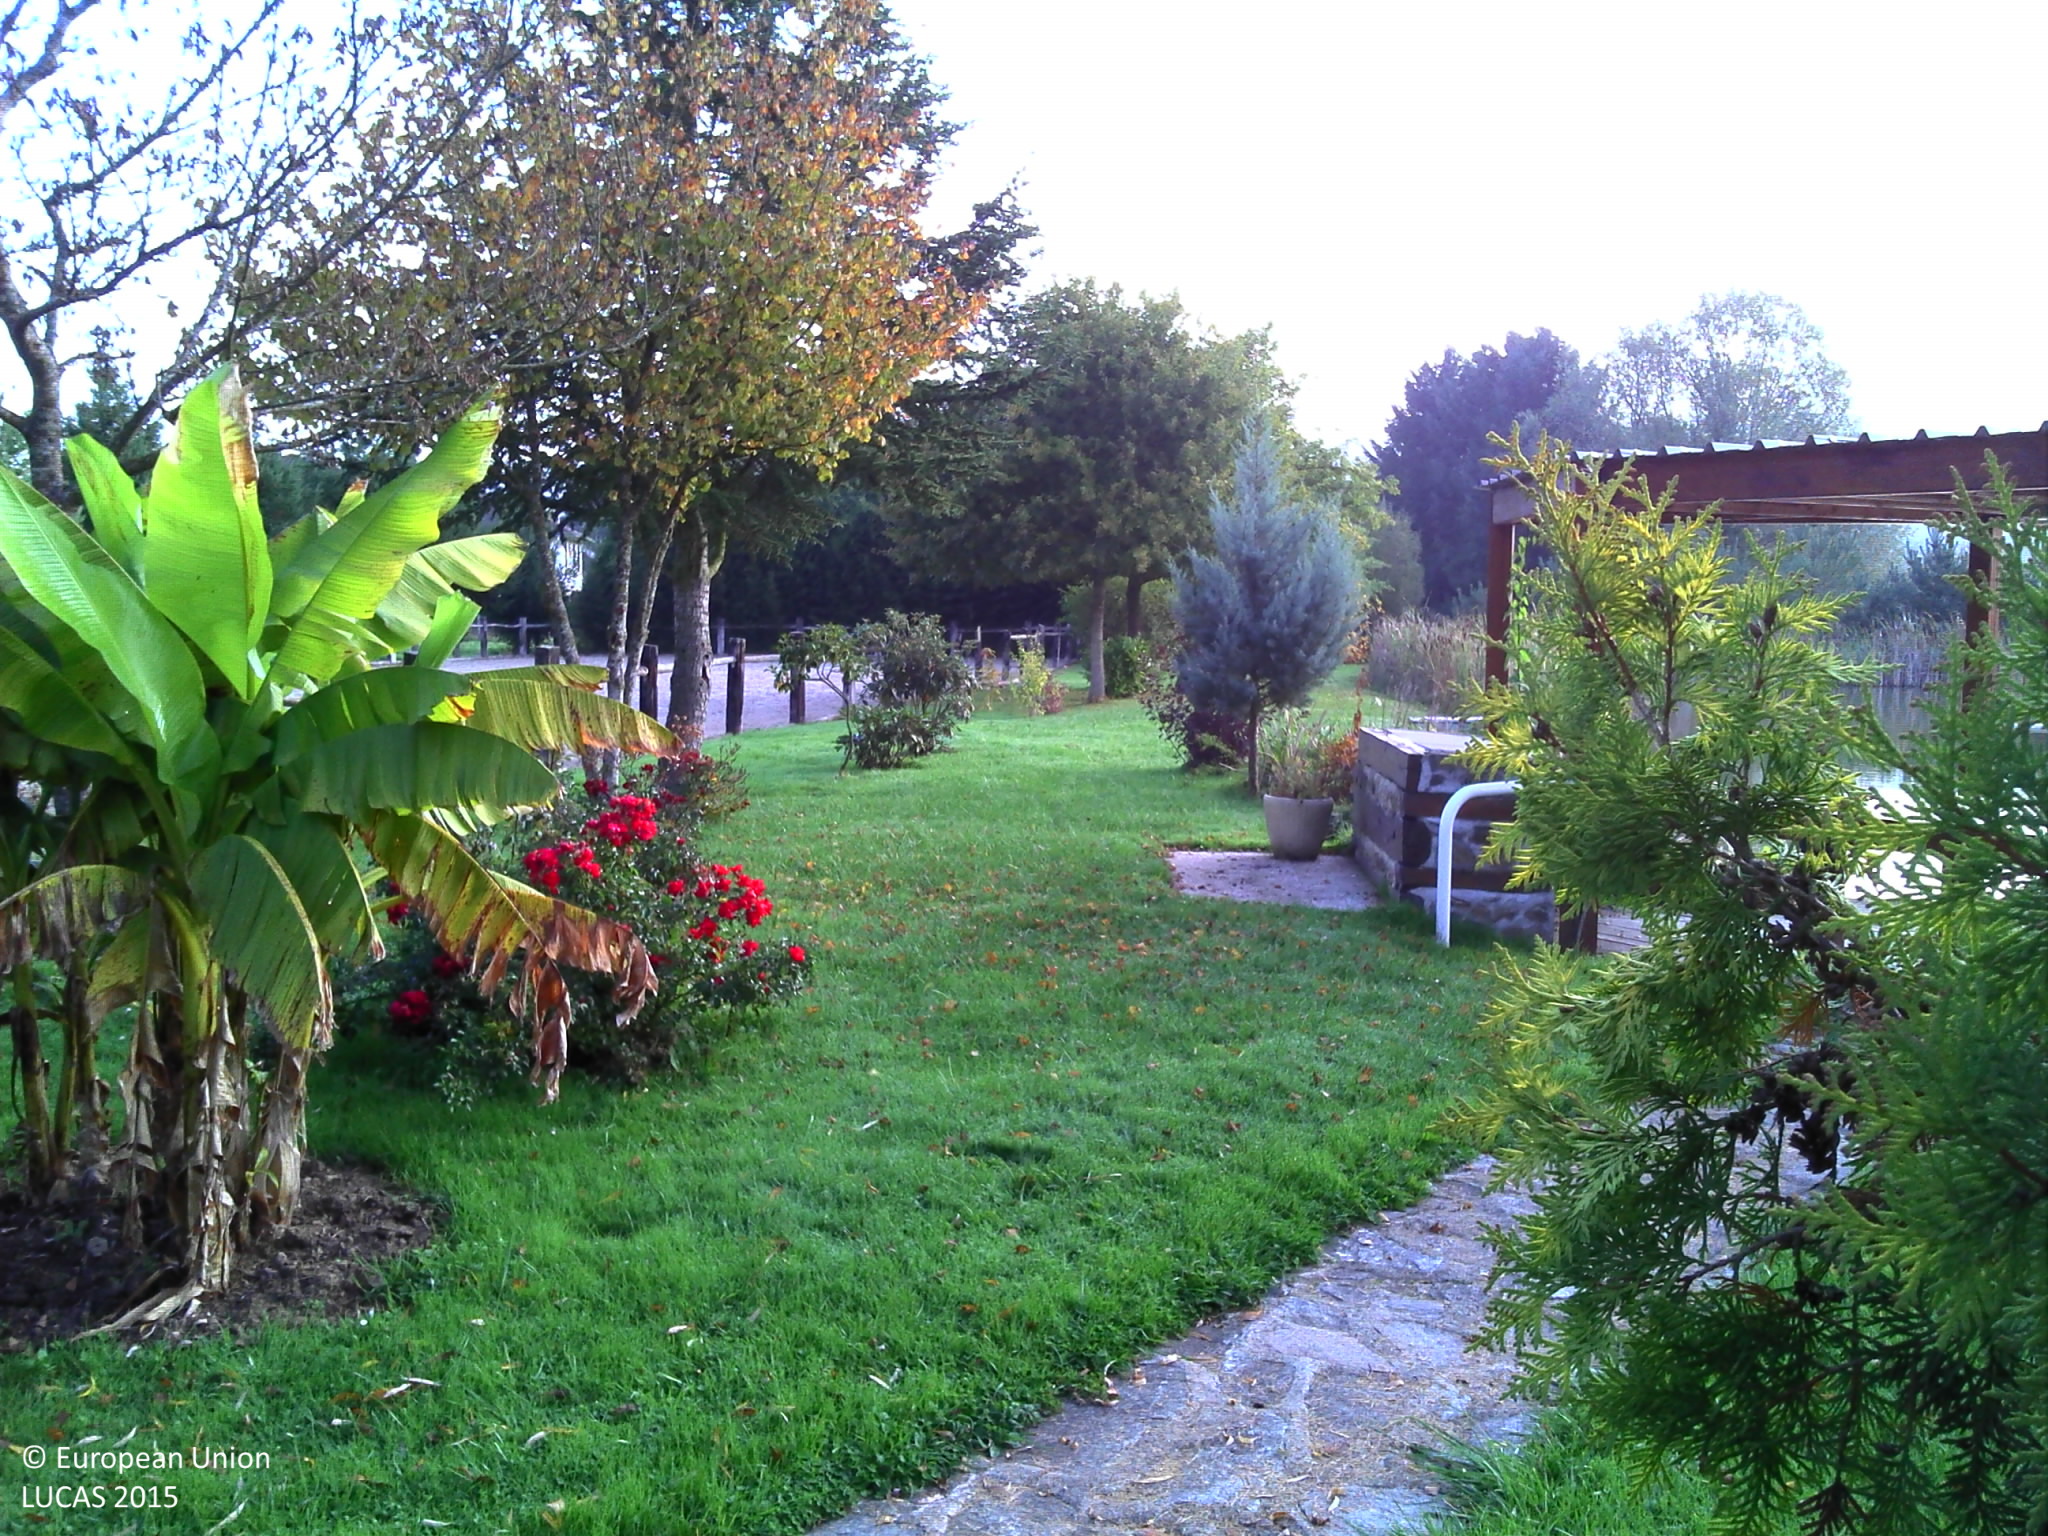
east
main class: Grassland
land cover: Grassland with sparse tree/shrub cover
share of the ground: > 75 %
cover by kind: herbaceous plants 95 %, coniferous forest trees 5 %
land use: Residential
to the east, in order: Tracks; Grassland with sparse tree/shrub cover; Inland marshes; Fences; Conifer hedges; Grassland without tree/shrub cover; Fences; Grassland without tree/shrub cover; Broadleaved woodland; Rivers and streams; Fences; Spontaneously vegetated surfaces; Grassland without tree/shrub cover; Spontaneously vegetated surfaces; Broadleaved woodland; Fences; Grassland without tree/shrub cover
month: October
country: FR
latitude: 46.1275
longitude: 2.8147
